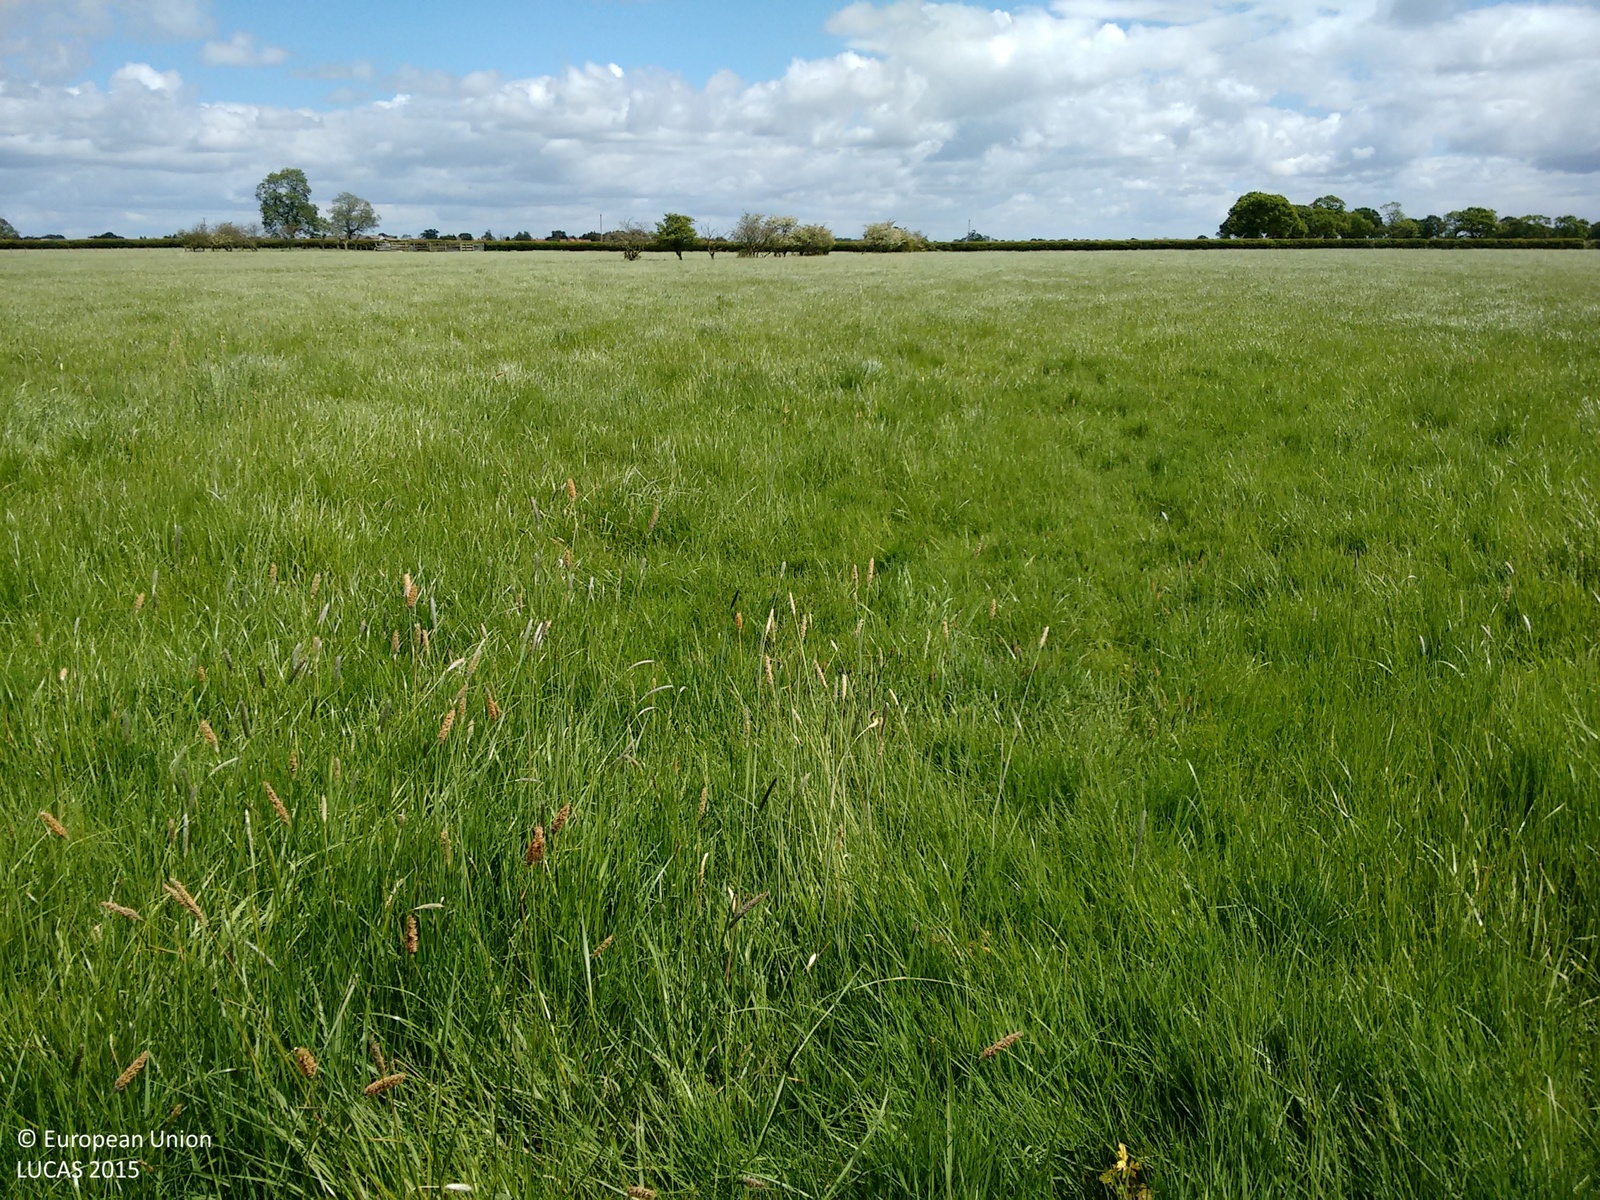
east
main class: Grassland
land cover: Grassland without tree/shrub cover
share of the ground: > 75 %
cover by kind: herbaceous plants 100 %
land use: Agriculture (excluding fallow land and kitchen gardens)
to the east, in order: Grassland without tree/shrub cover; Managed hedges; Ditches and canals; Grass margins; Paved roads, cycling and walking lanes
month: May
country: GB
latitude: 53.9683
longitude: -1.2195
